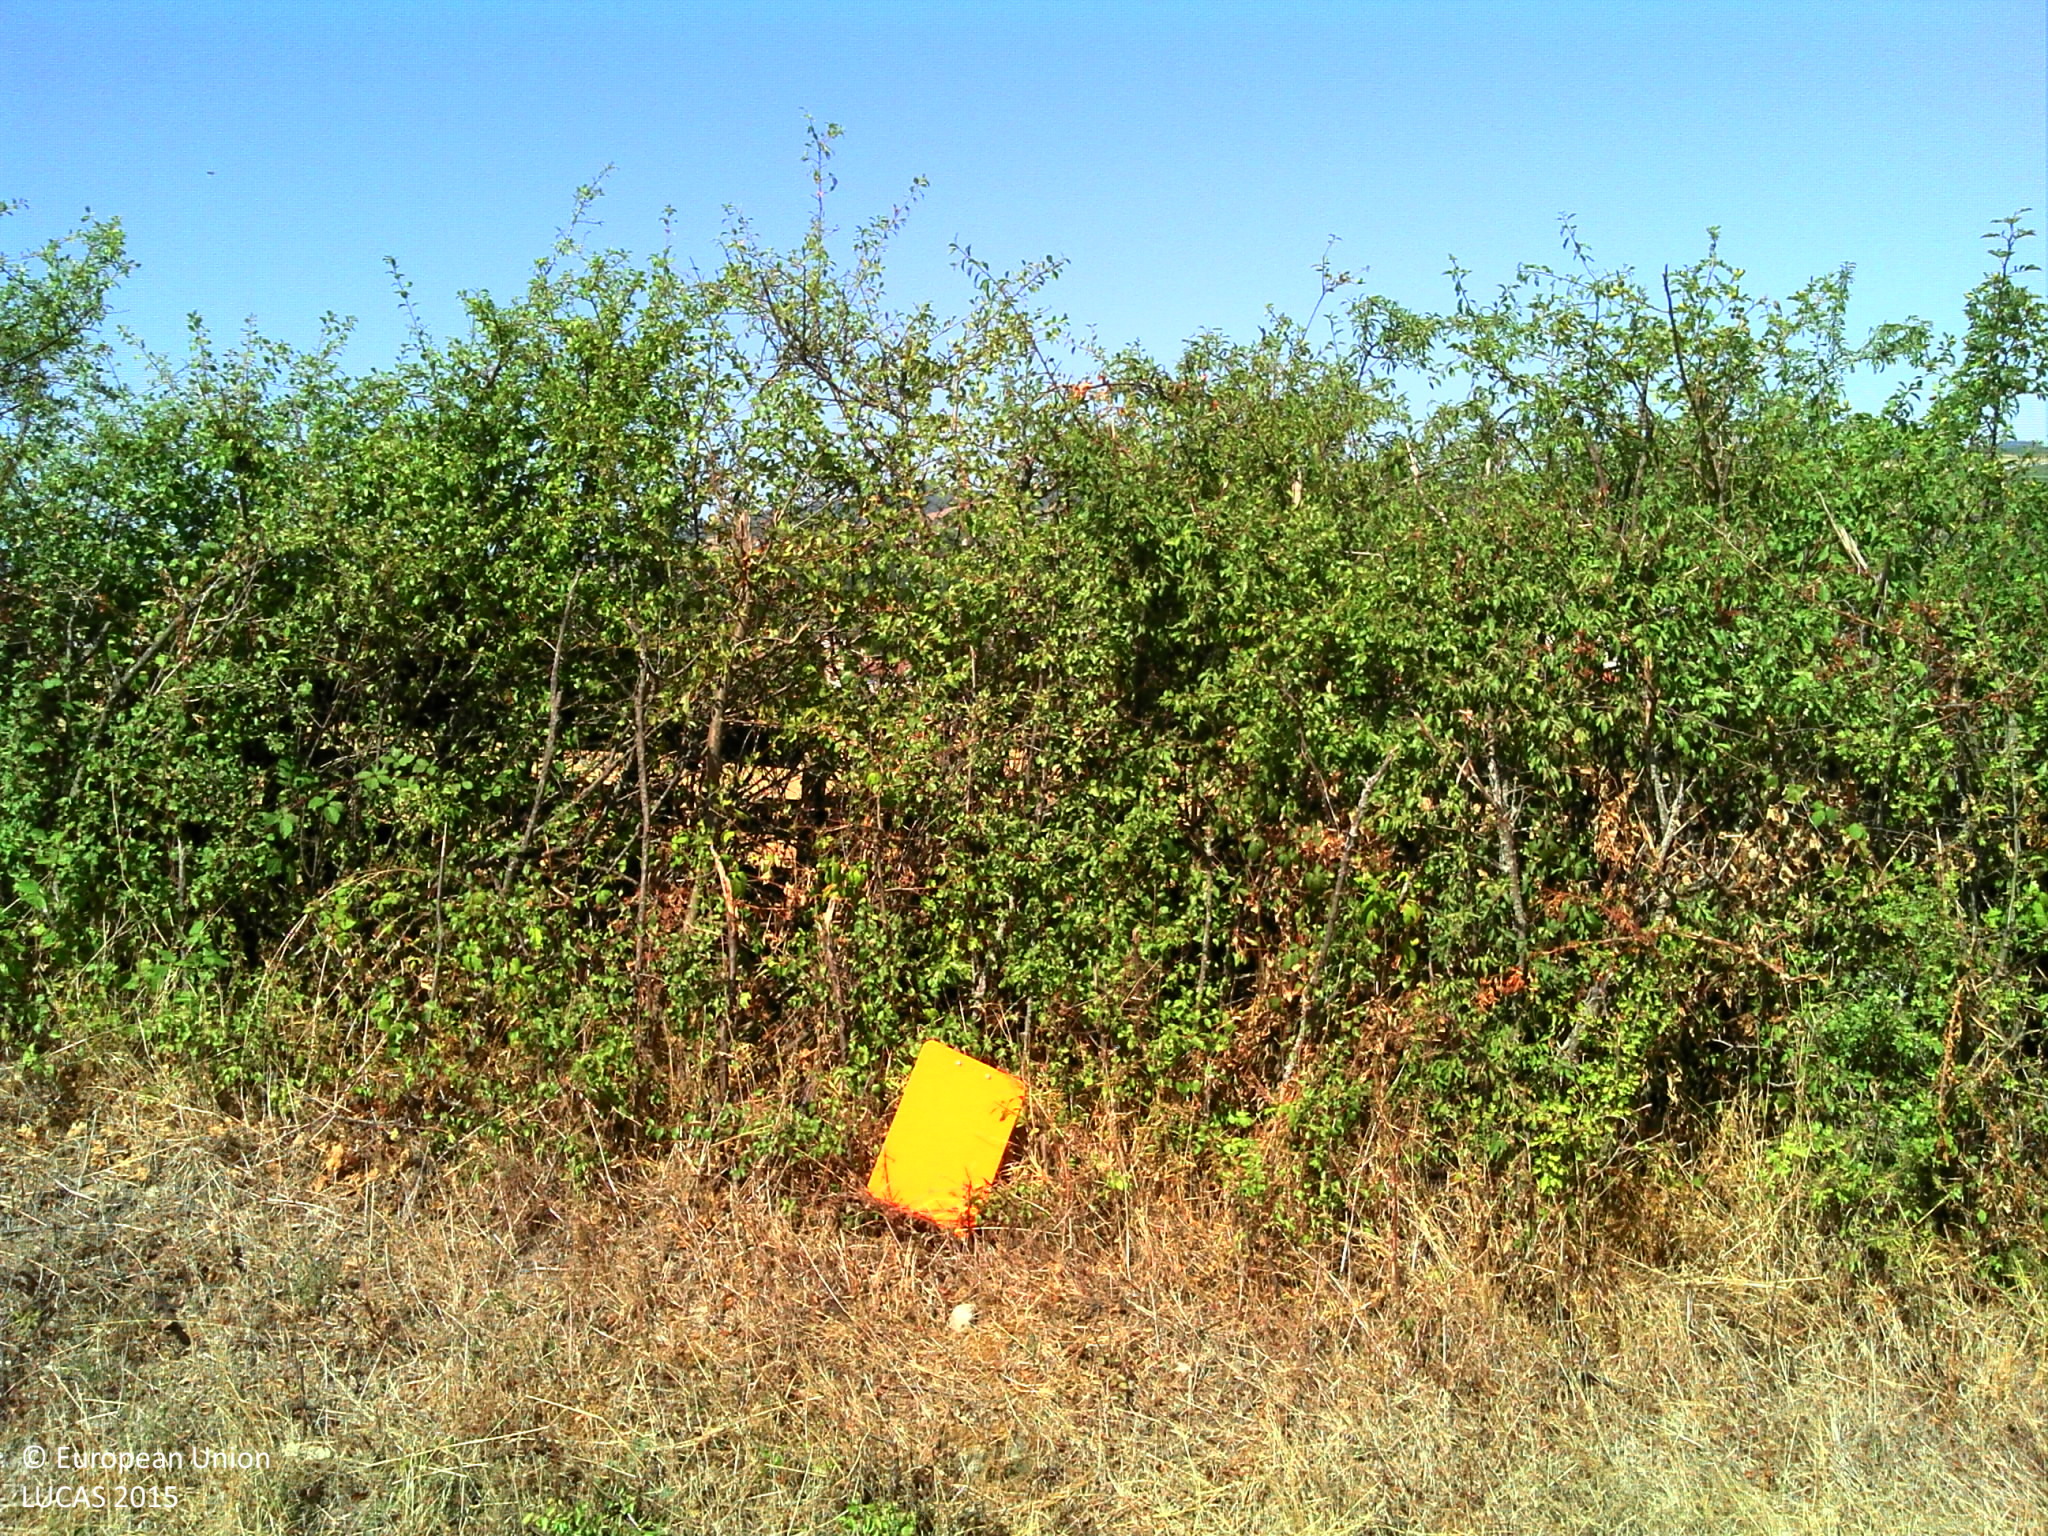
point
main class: Grassland
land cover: Grassland without tree/shrub cover
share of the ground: > 75 %
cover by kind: herbaceous plants 90 %, unconsolidated bare surface 10 %
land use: Agriculture (excluding fallow land and kitchen gardens)
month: August
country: FR
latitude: 45.5102
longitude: 4.5895
